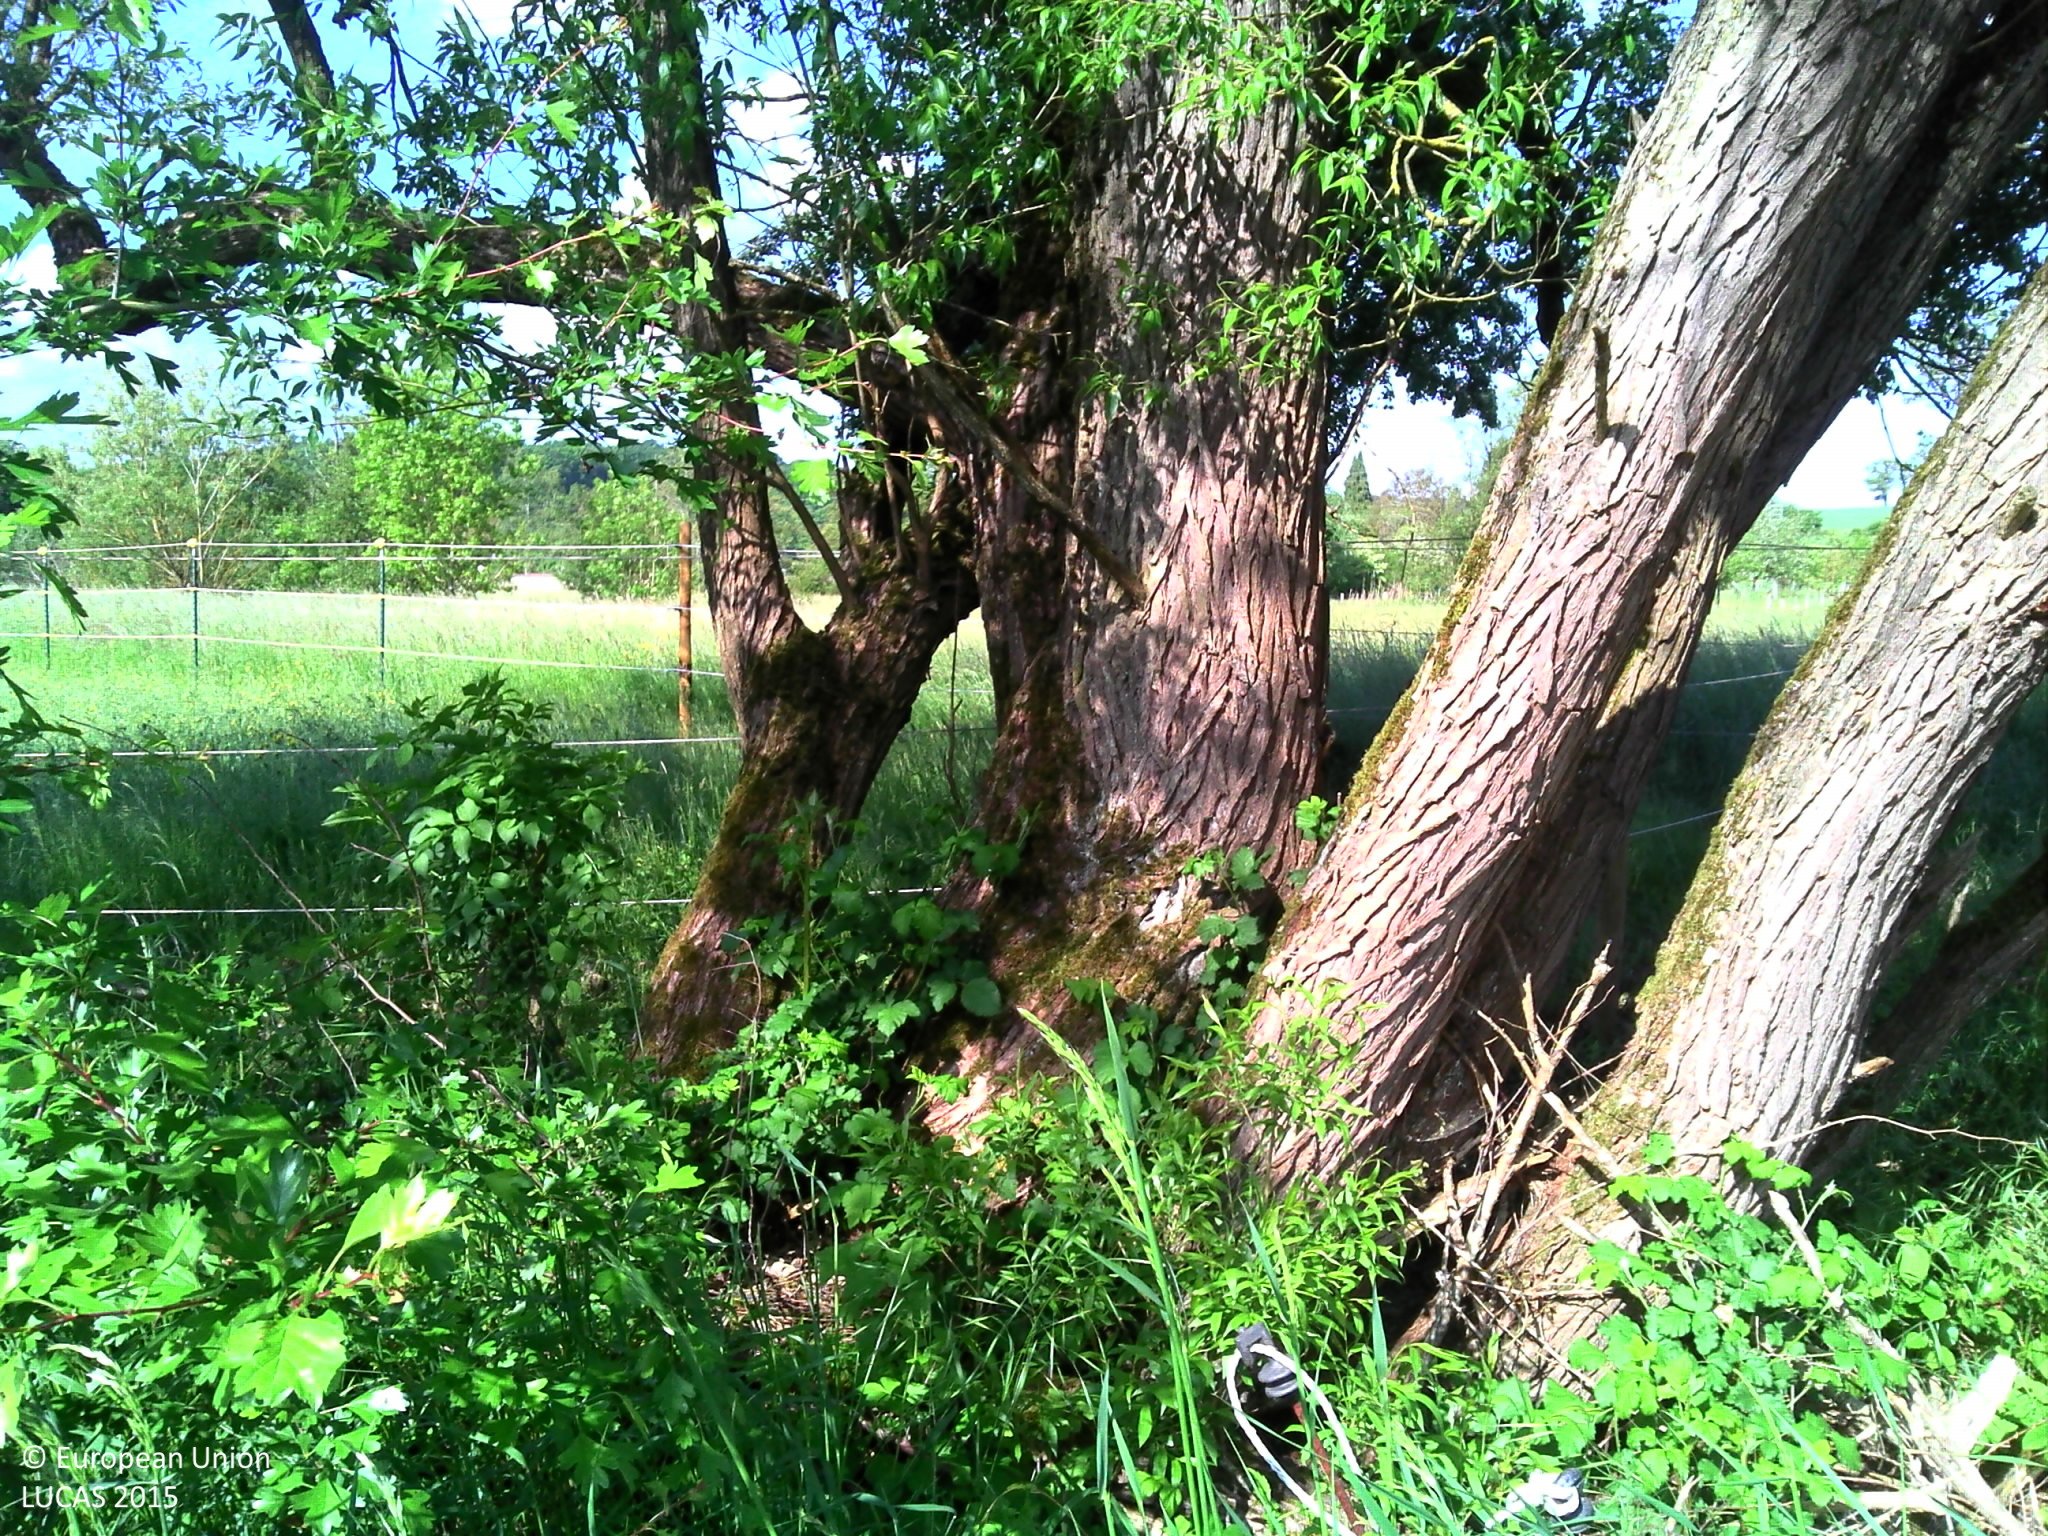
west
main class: Woodland
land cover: Broadleaved woodland
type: floodplain forest
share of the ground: > 75 %
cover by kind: broadleaved forest trees 80 %, herbaceous plants 15 %, shrubs 5 %
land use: Agriculture (excluding fallow land and kitchen gardens)
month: May
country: LU
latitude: 49.6562
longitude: 6.3010
